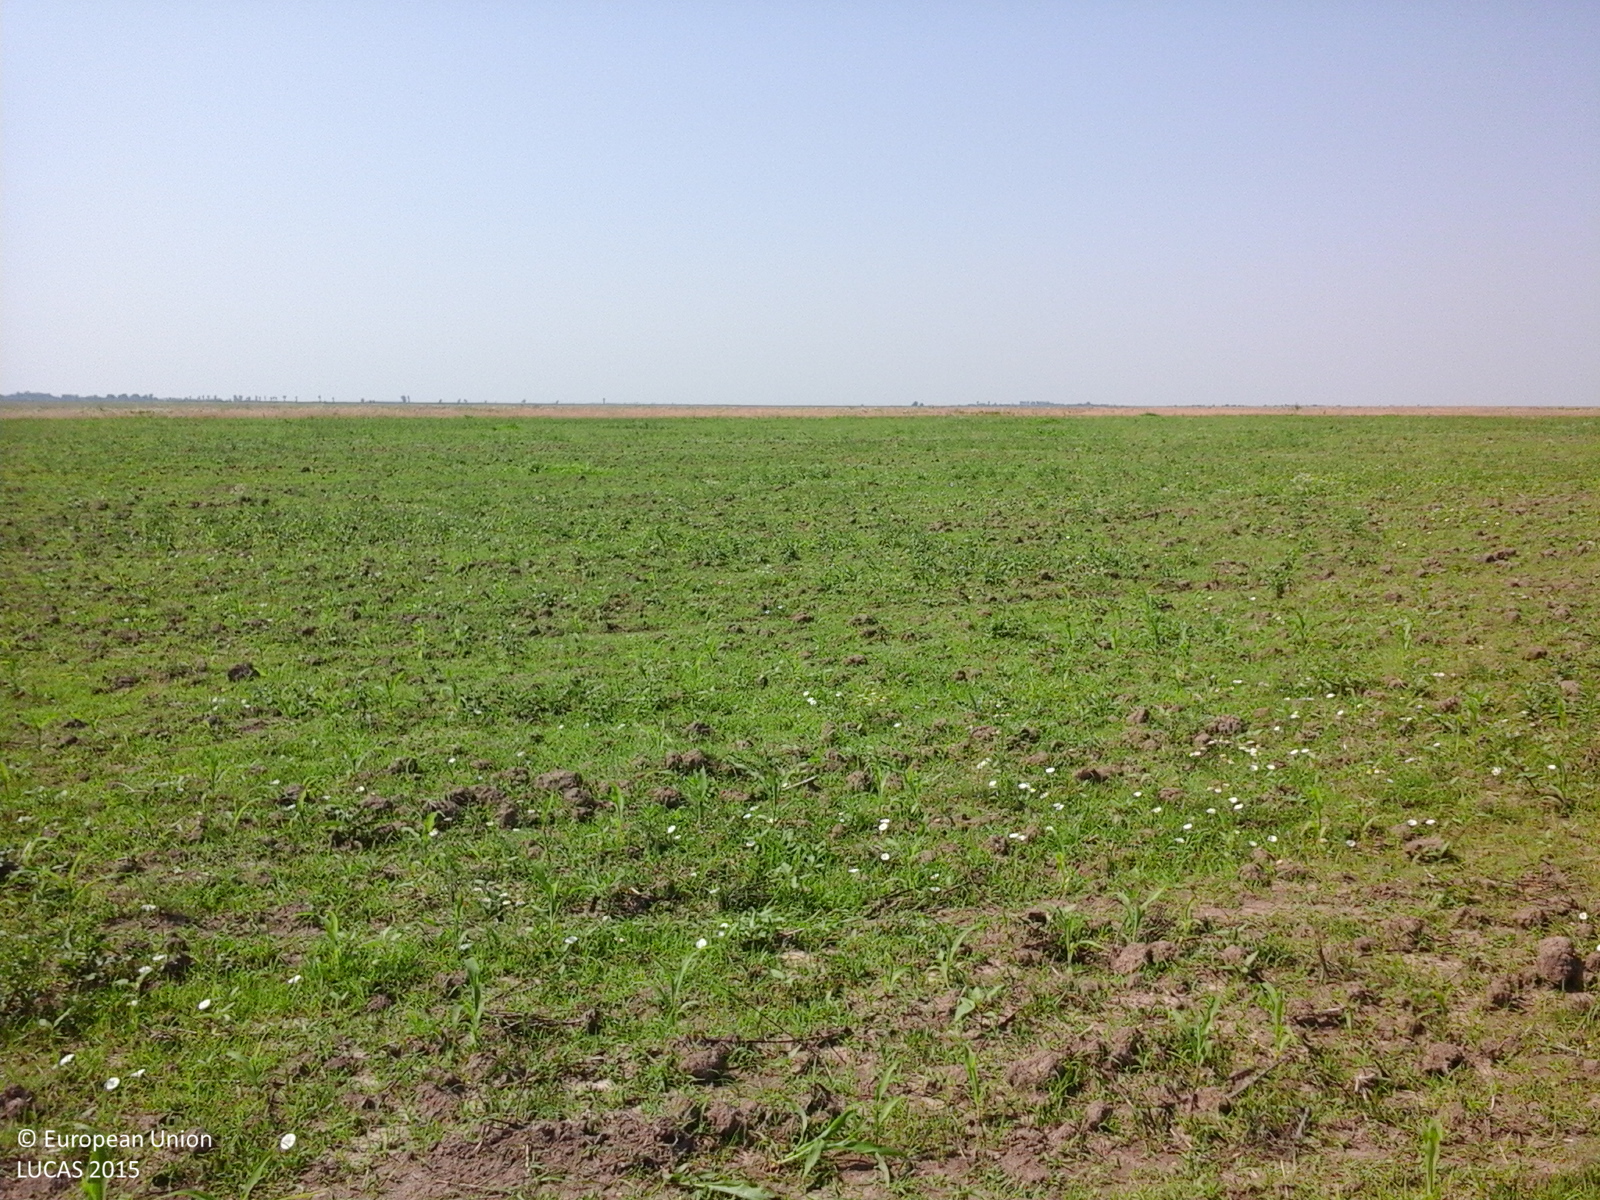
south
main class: Cropland
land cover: Maize
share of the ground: < 10 %
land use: Agriculture (excluding fallow land and kitchen gardens)
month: July
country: RO
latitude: 44.5292
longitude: 24.9152
